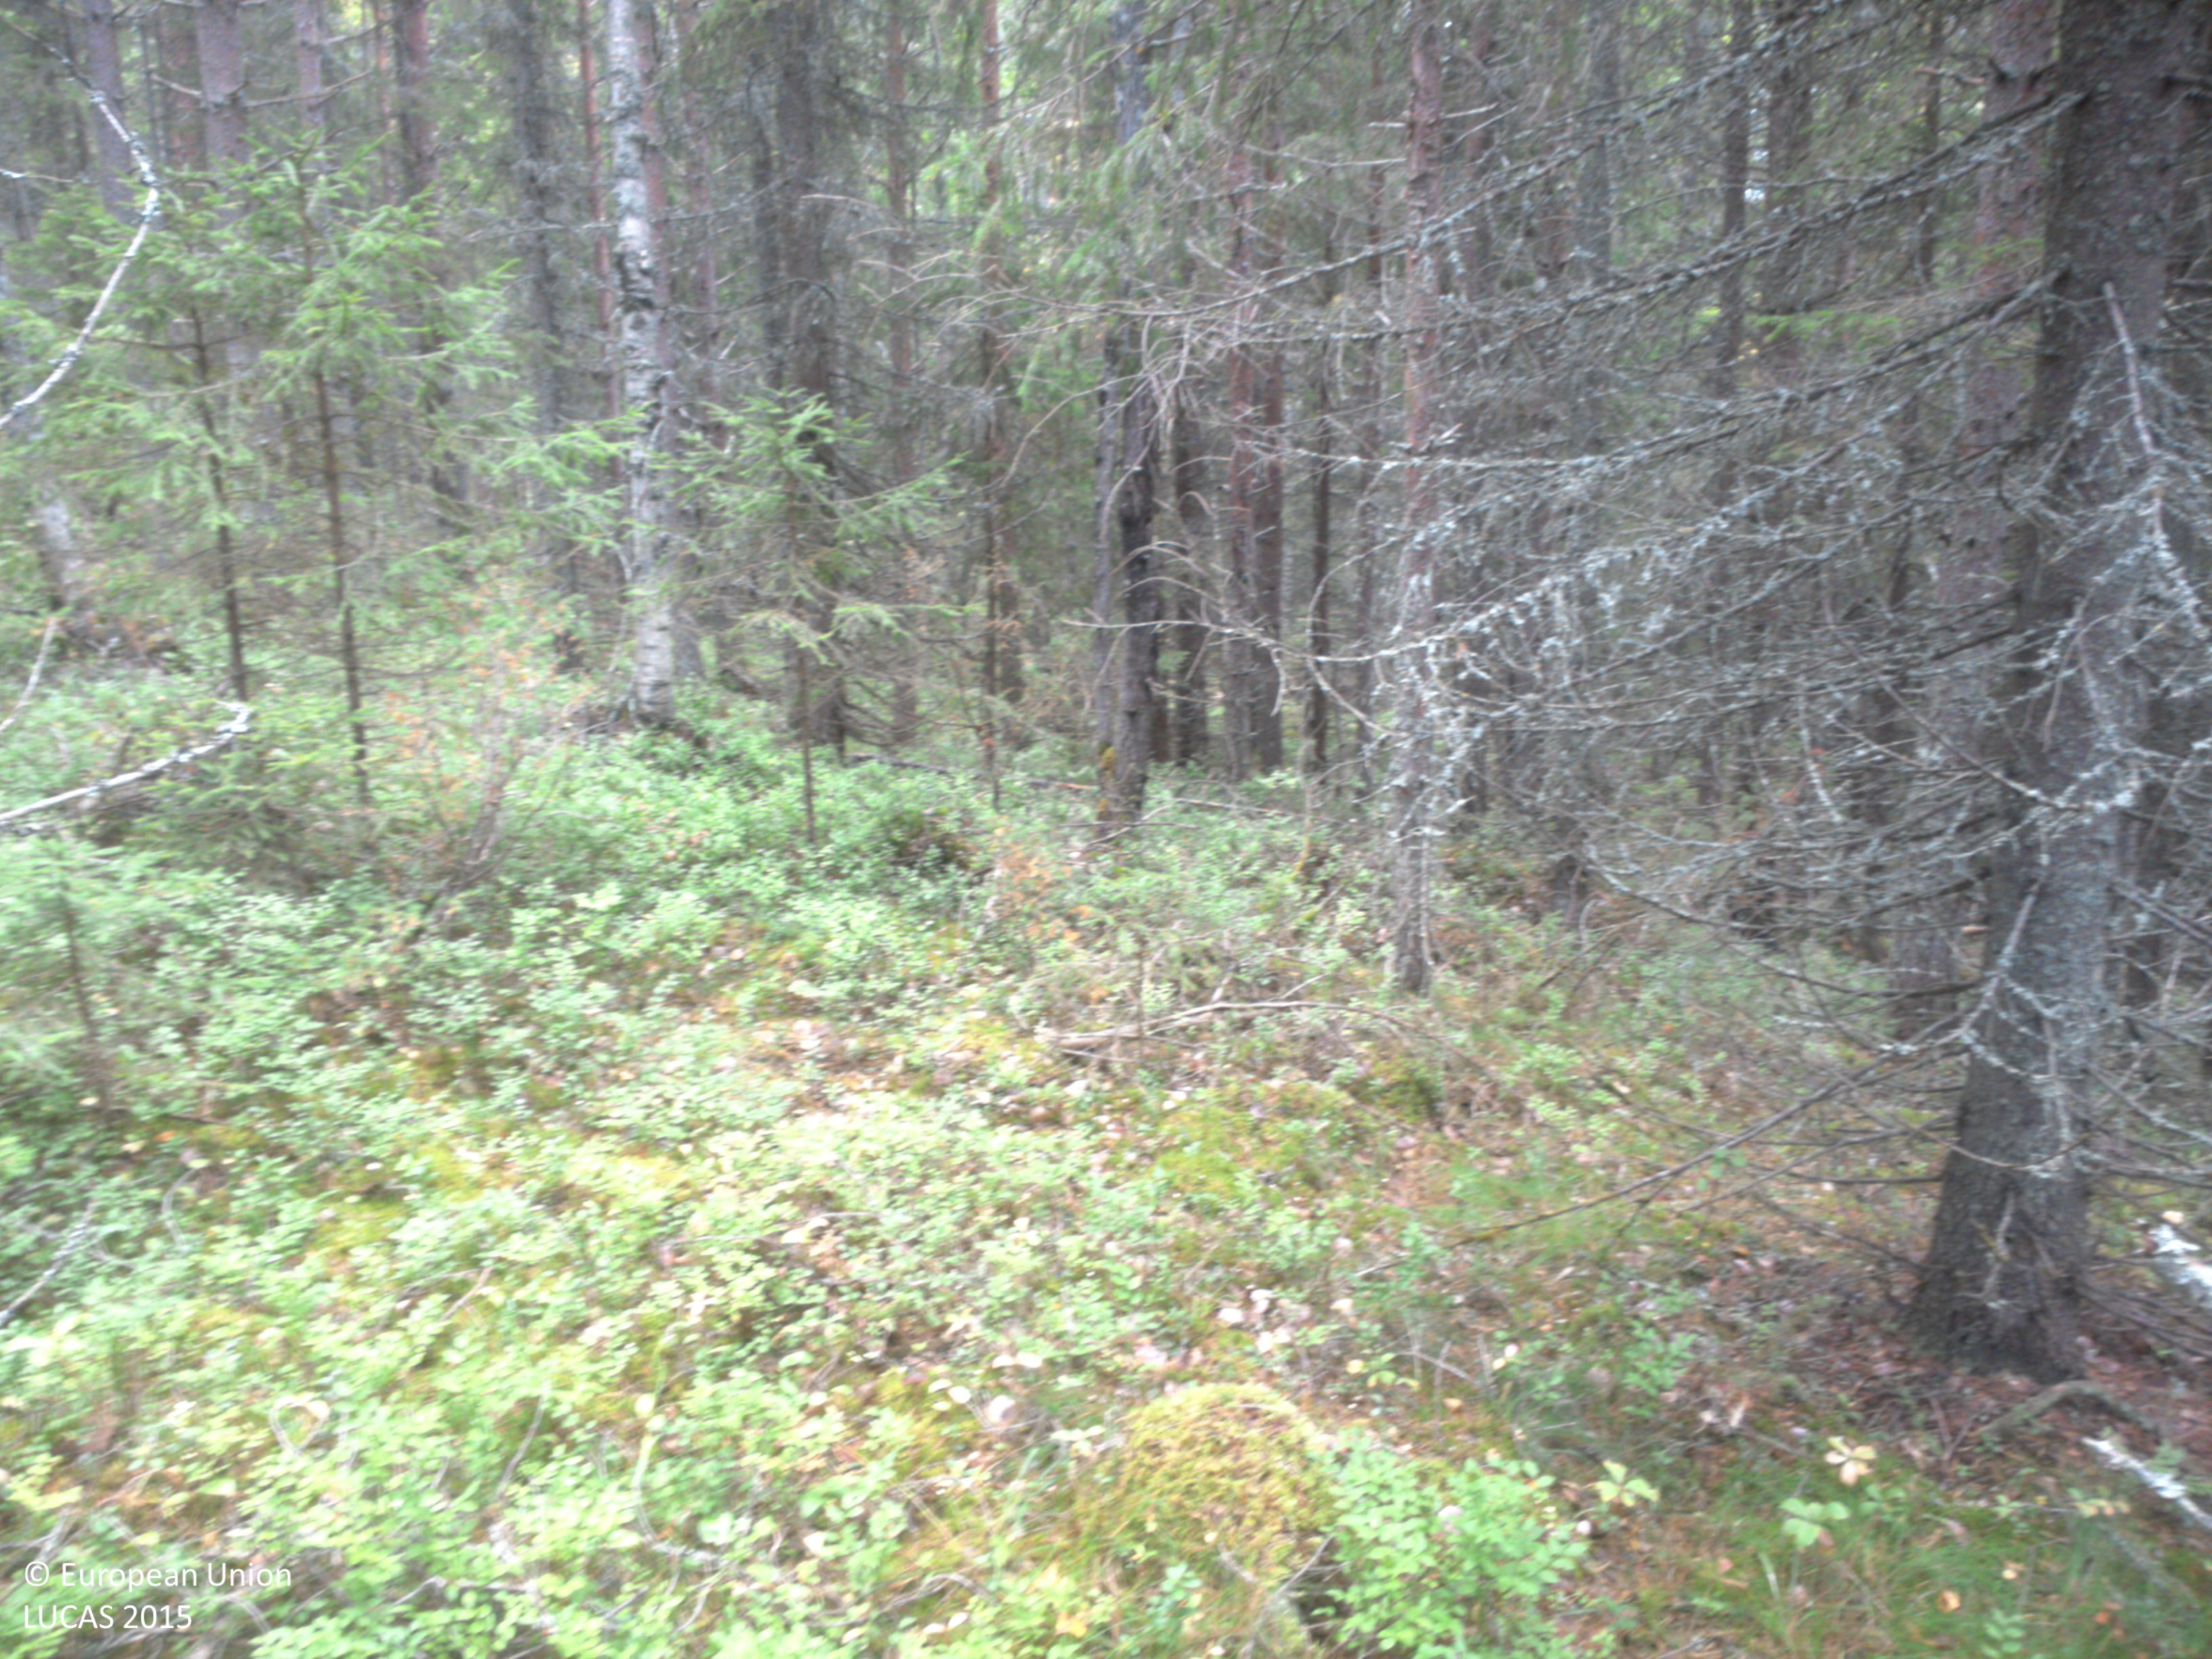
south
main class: Woodland
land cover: Pine dominated mixed woodland
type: boreal forest
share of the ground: 50 - 75 %
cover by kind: shrubs 45 %, coniferous forest trees 40 %, broadleaved forest trees 15 %
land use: Forestry
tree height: > 5 m
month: August
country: SE
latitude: 63.8473
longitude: 19.9642
